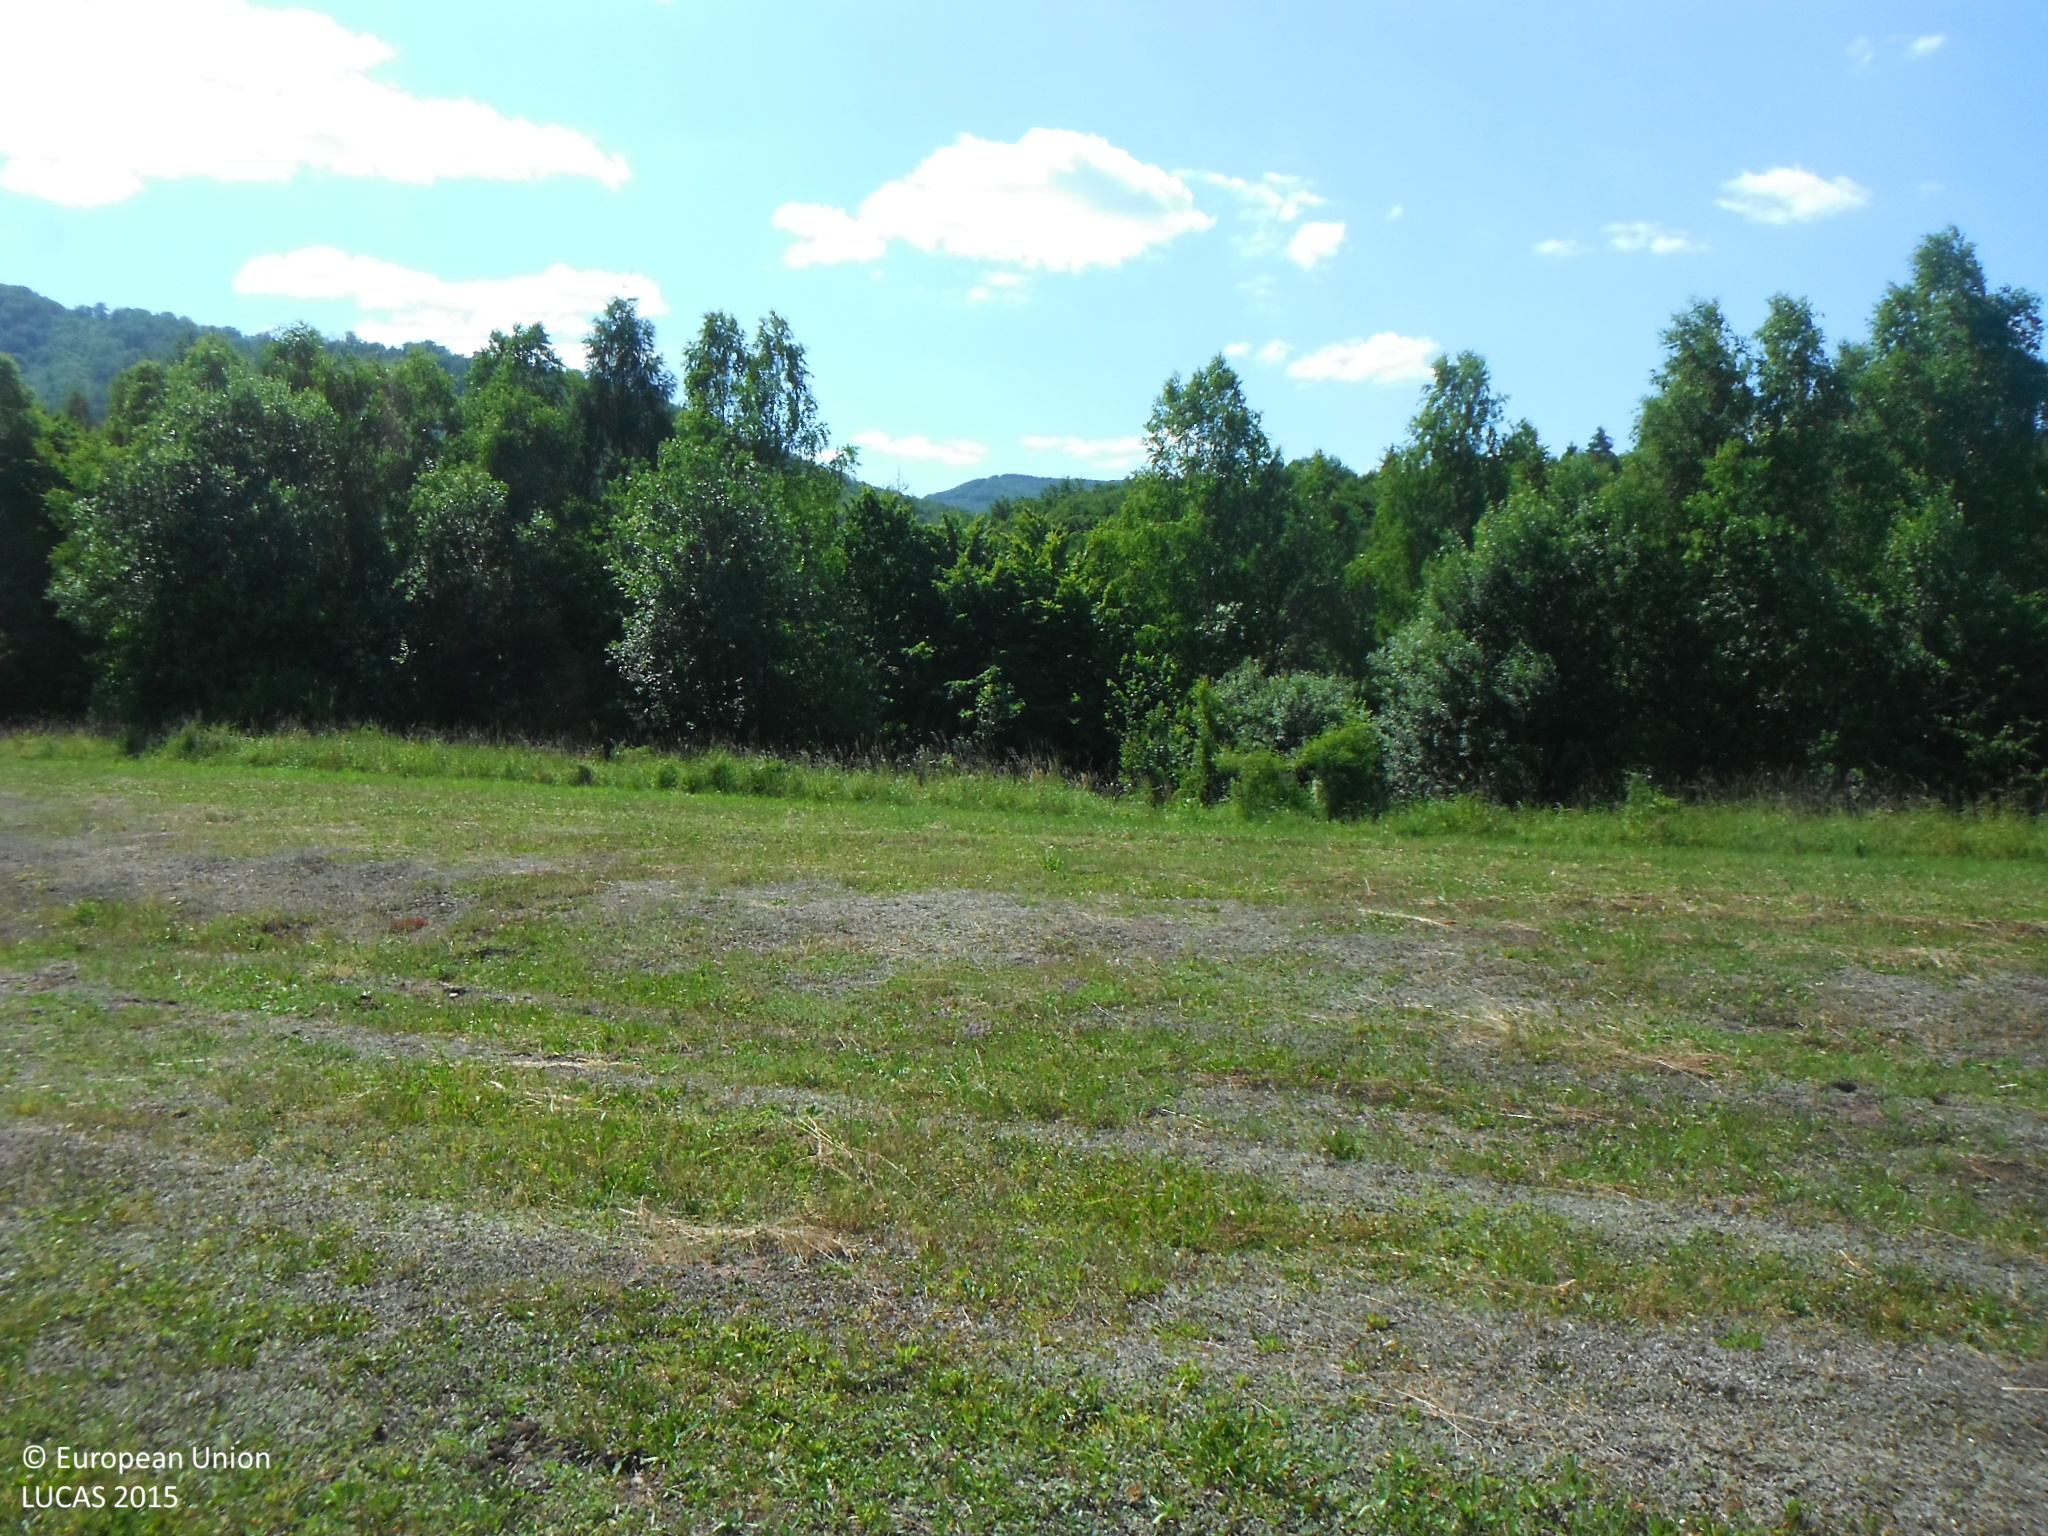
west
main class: Grassland
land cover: Grassland without tree/shrub cover
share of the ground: > 75 %
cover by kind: herbaceous plants 100 %
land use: Agriculture (excluding fallow land and kitchen gardens)
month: July
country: SK
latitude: 49.0680
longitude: 22.3942
